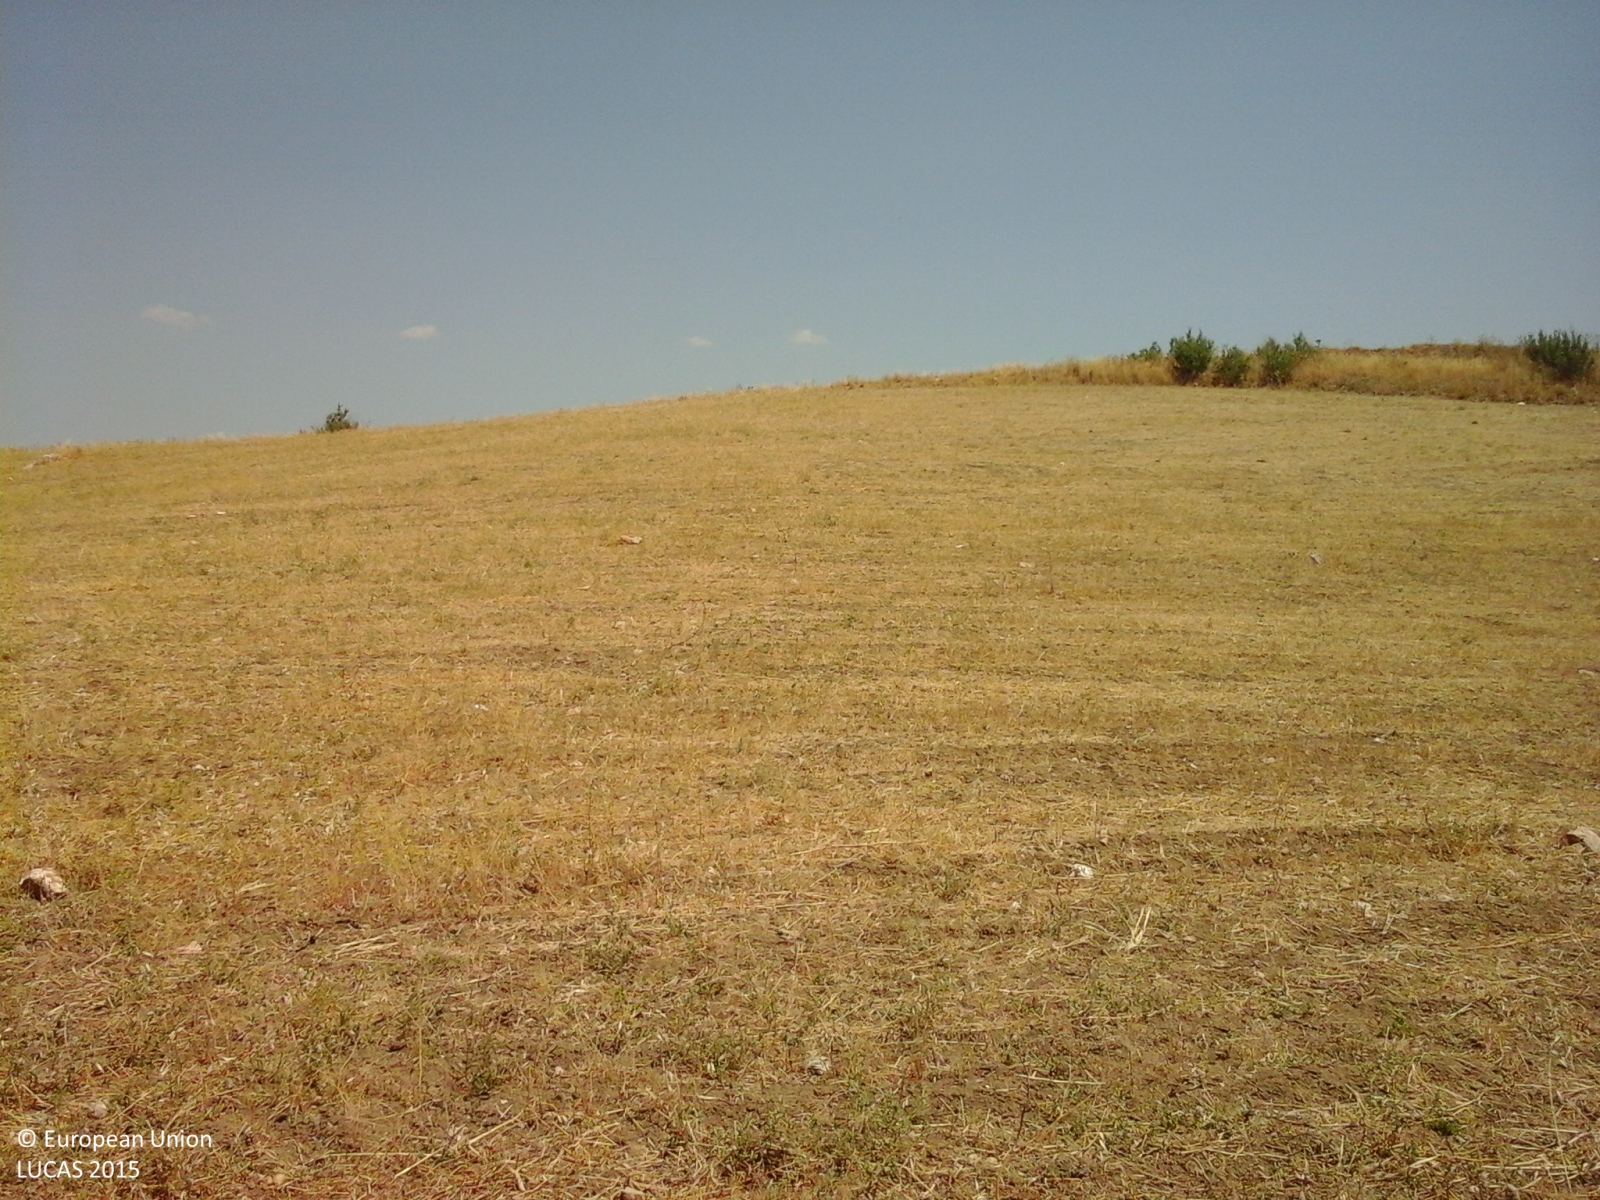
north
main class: Grassland
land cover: Spontaneously vegetated surfaces
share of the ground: > 75 %
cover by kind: herbaceous plants 100 %
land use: Agriculture (excluding fallow land and kitchen gardens)
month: July
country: IT
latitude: 37.4457
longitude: 13.5335
